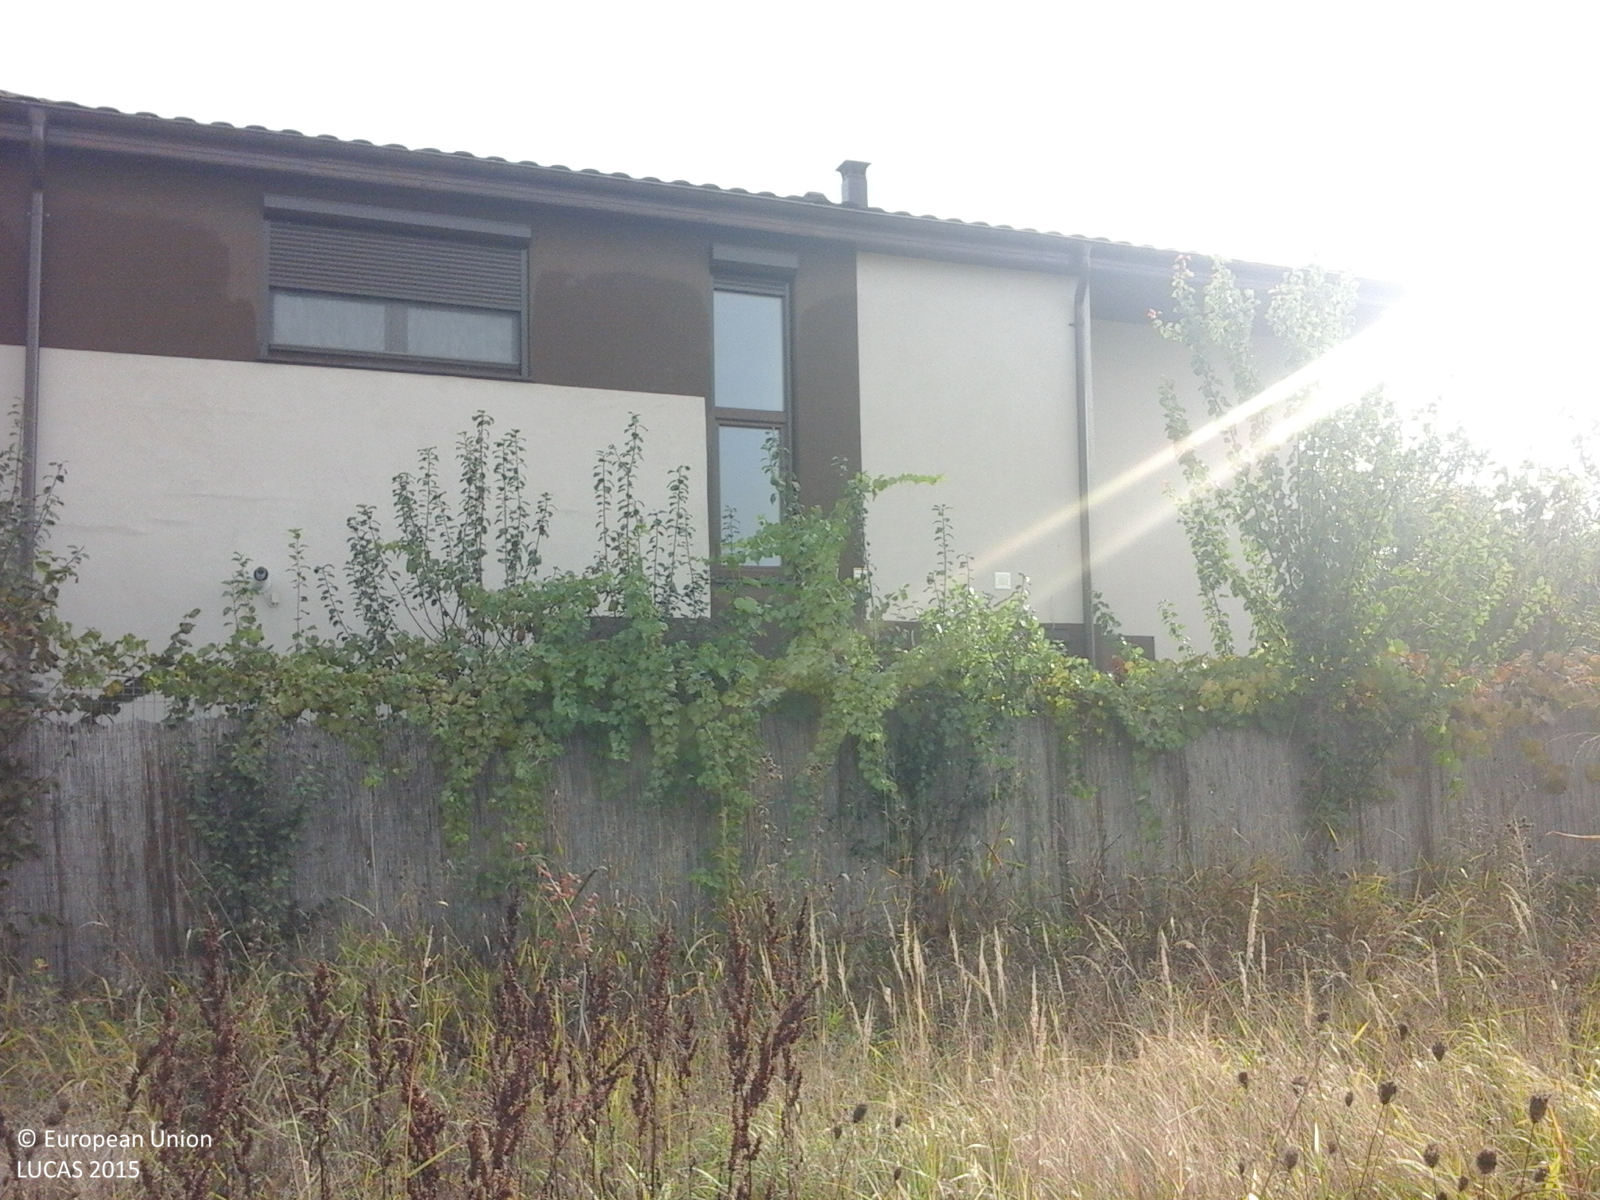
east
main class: Grassland
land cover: Spontaneously vegetated surfaces
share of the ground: > 75 %
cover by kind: herbaceous plants 100 %
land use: Fallow land
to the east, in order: Spontaneously vegetated surfaces; Artificial constructions in urban areas; Spontaneously vegetated surfaces; Artificial constructions in urban areas; Spontaneously vegetated surfaces; Artificial constructions in urban areas; Spontaneously vegetated surfaces; Artificial constructions in urban areas
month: October
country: RO
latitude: 44.6782
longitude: 26.1169
